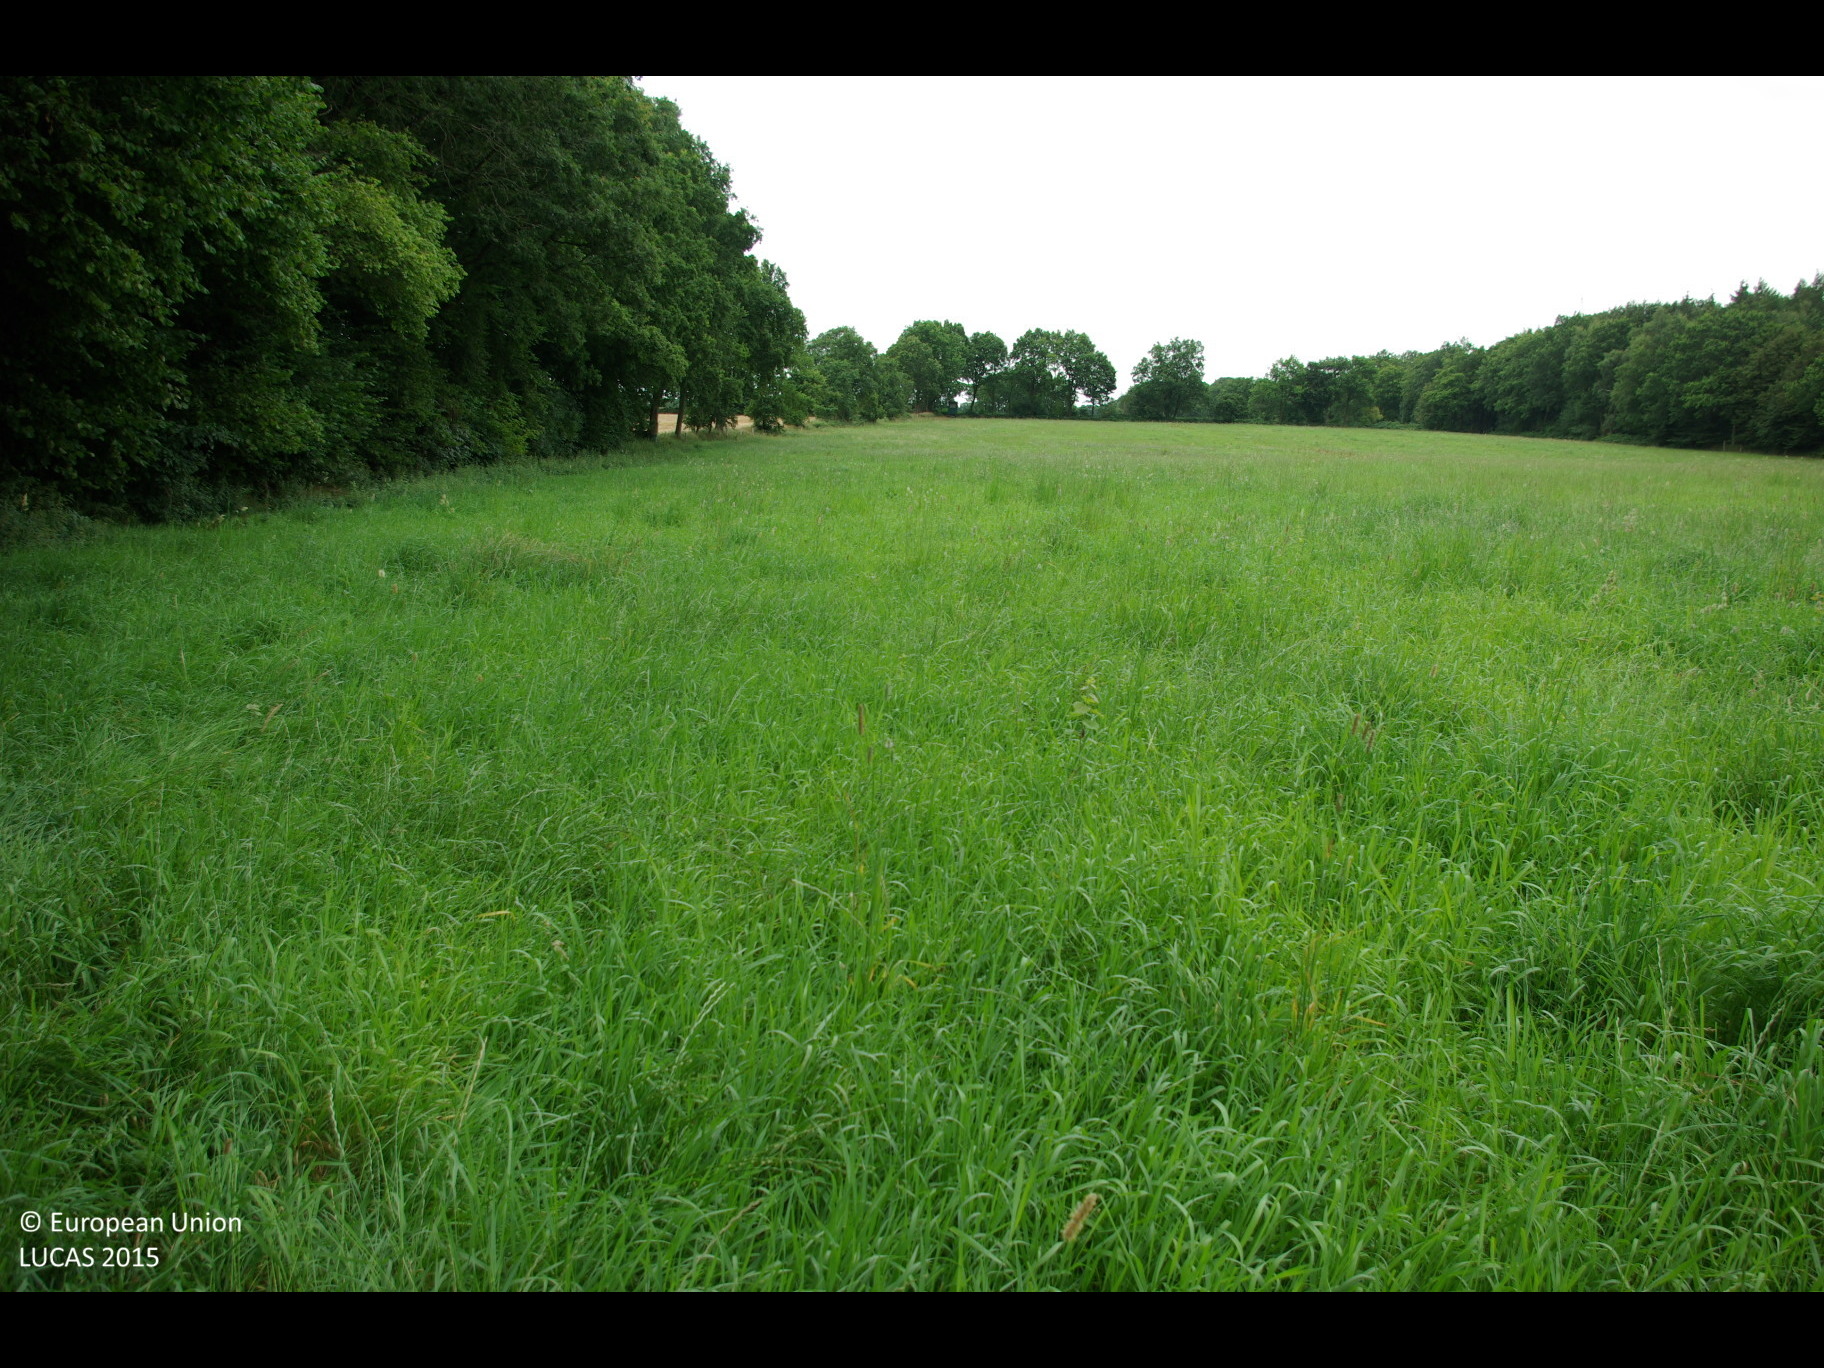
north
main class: Grassland
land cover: Grassland without tree/shrub cover
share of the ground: > 75 %
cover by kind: herbaceous plants 100 %
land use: Agriculture (excluding fallow land and kitchen gardens)
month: August
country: DE
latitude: 54.1009
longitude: 9.3122
